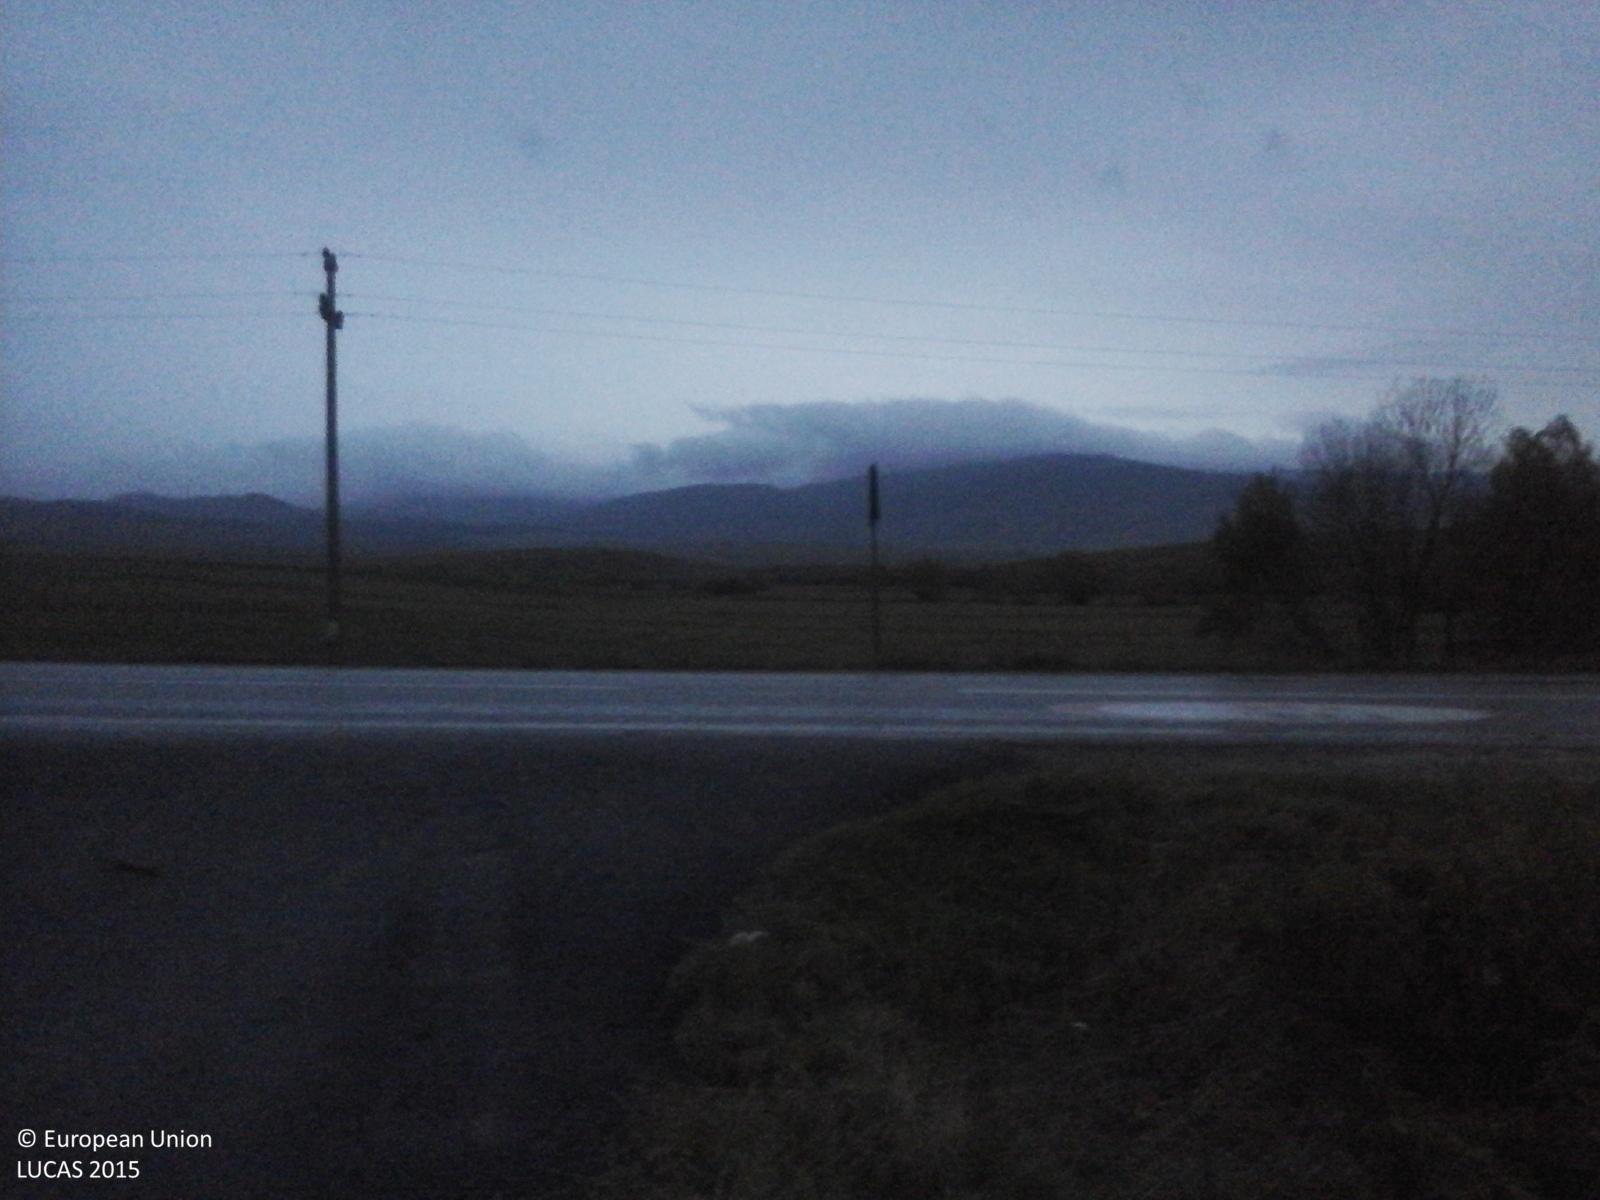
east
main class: Grassland
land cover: Grassland without tree/shrub cover
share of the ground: > 75 %
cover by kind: herbaceous plants 100 %
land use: Agriculture (excluding fallow land and kitchen gardens)
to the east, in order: Grassland without tree/shrub cover; Broadleaved woodland; Rivers and streams; Broadleaved woodland; Grassland without tree/shrub cover; Broadleaved woodland; Rivers and streams; Broadleaved woodland; Grassland without tree/shrub cover; Broadleaved woodland; Rivers and streams; Broadleaved woodland; Grassland without tree/shrub cover; Broadleaved woodland; Rivers and streams; Broadleaved woodland; Grassland without tree/shrub cover
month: October
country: RO
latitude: 46.8271
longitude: 25.4878
